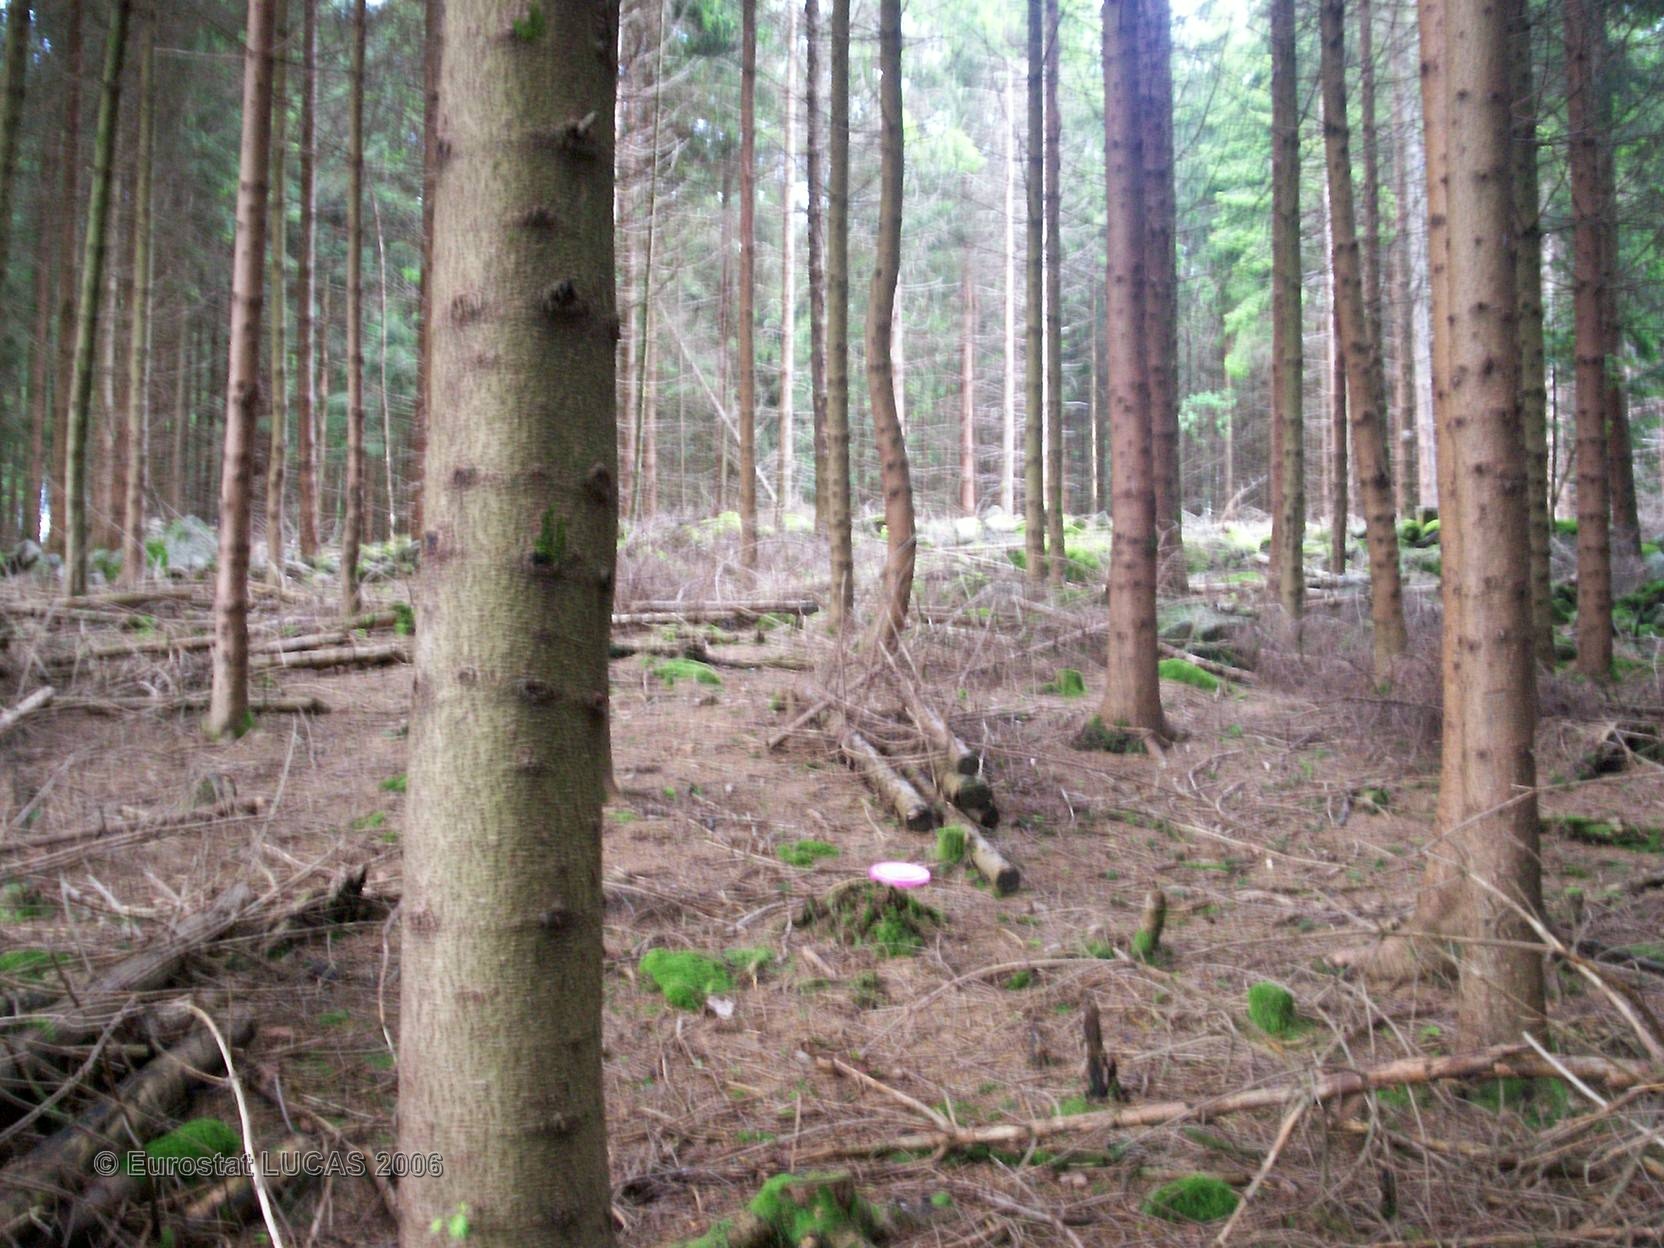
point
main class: Woodland
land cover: Coniferous forest
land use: Forestry
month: June
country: FR
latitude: 48.1041
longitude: 6.7645
